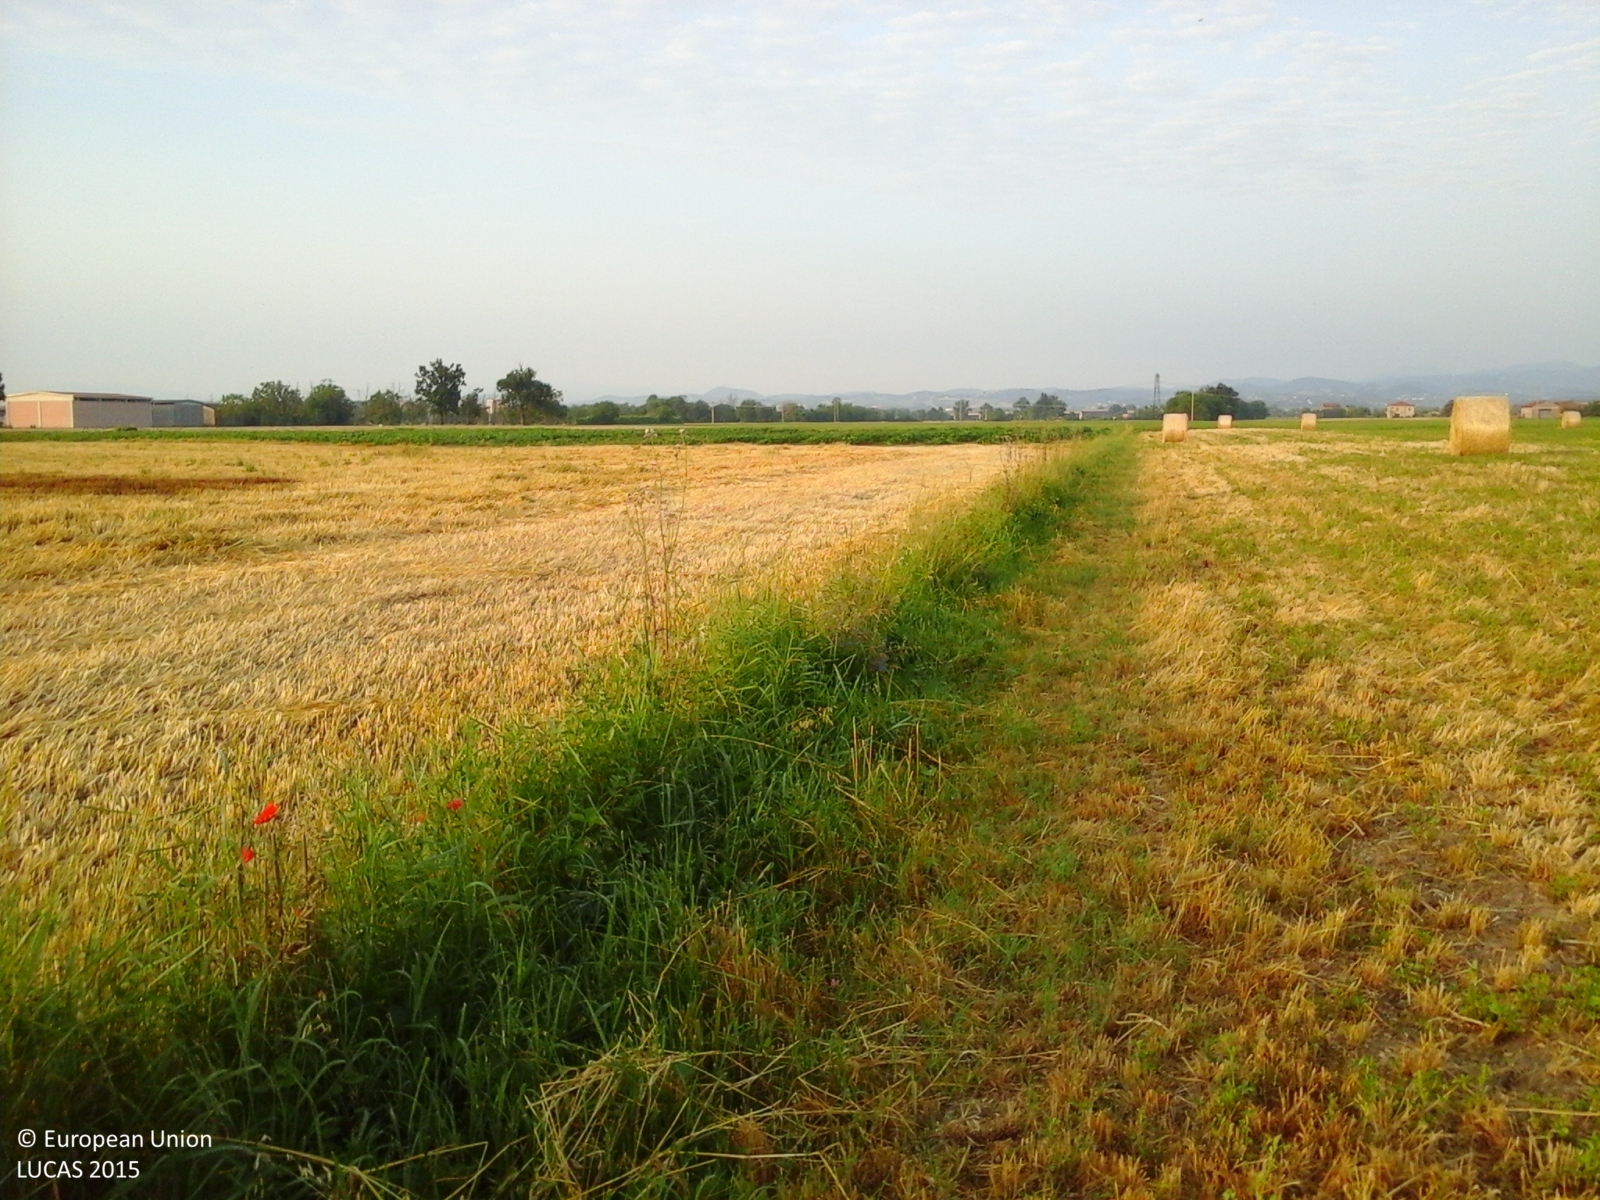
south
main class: Grassland
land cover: Spontaneously vegetated surfaces
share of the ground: 10 - 25 %
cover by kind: unconsolidated bare surface 90 %, herbaceous plants 10 %
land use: Agriculture (excluding fallow land and kitchen gardens)
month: June
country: IT
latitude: 44.8915
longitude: 10.0632
